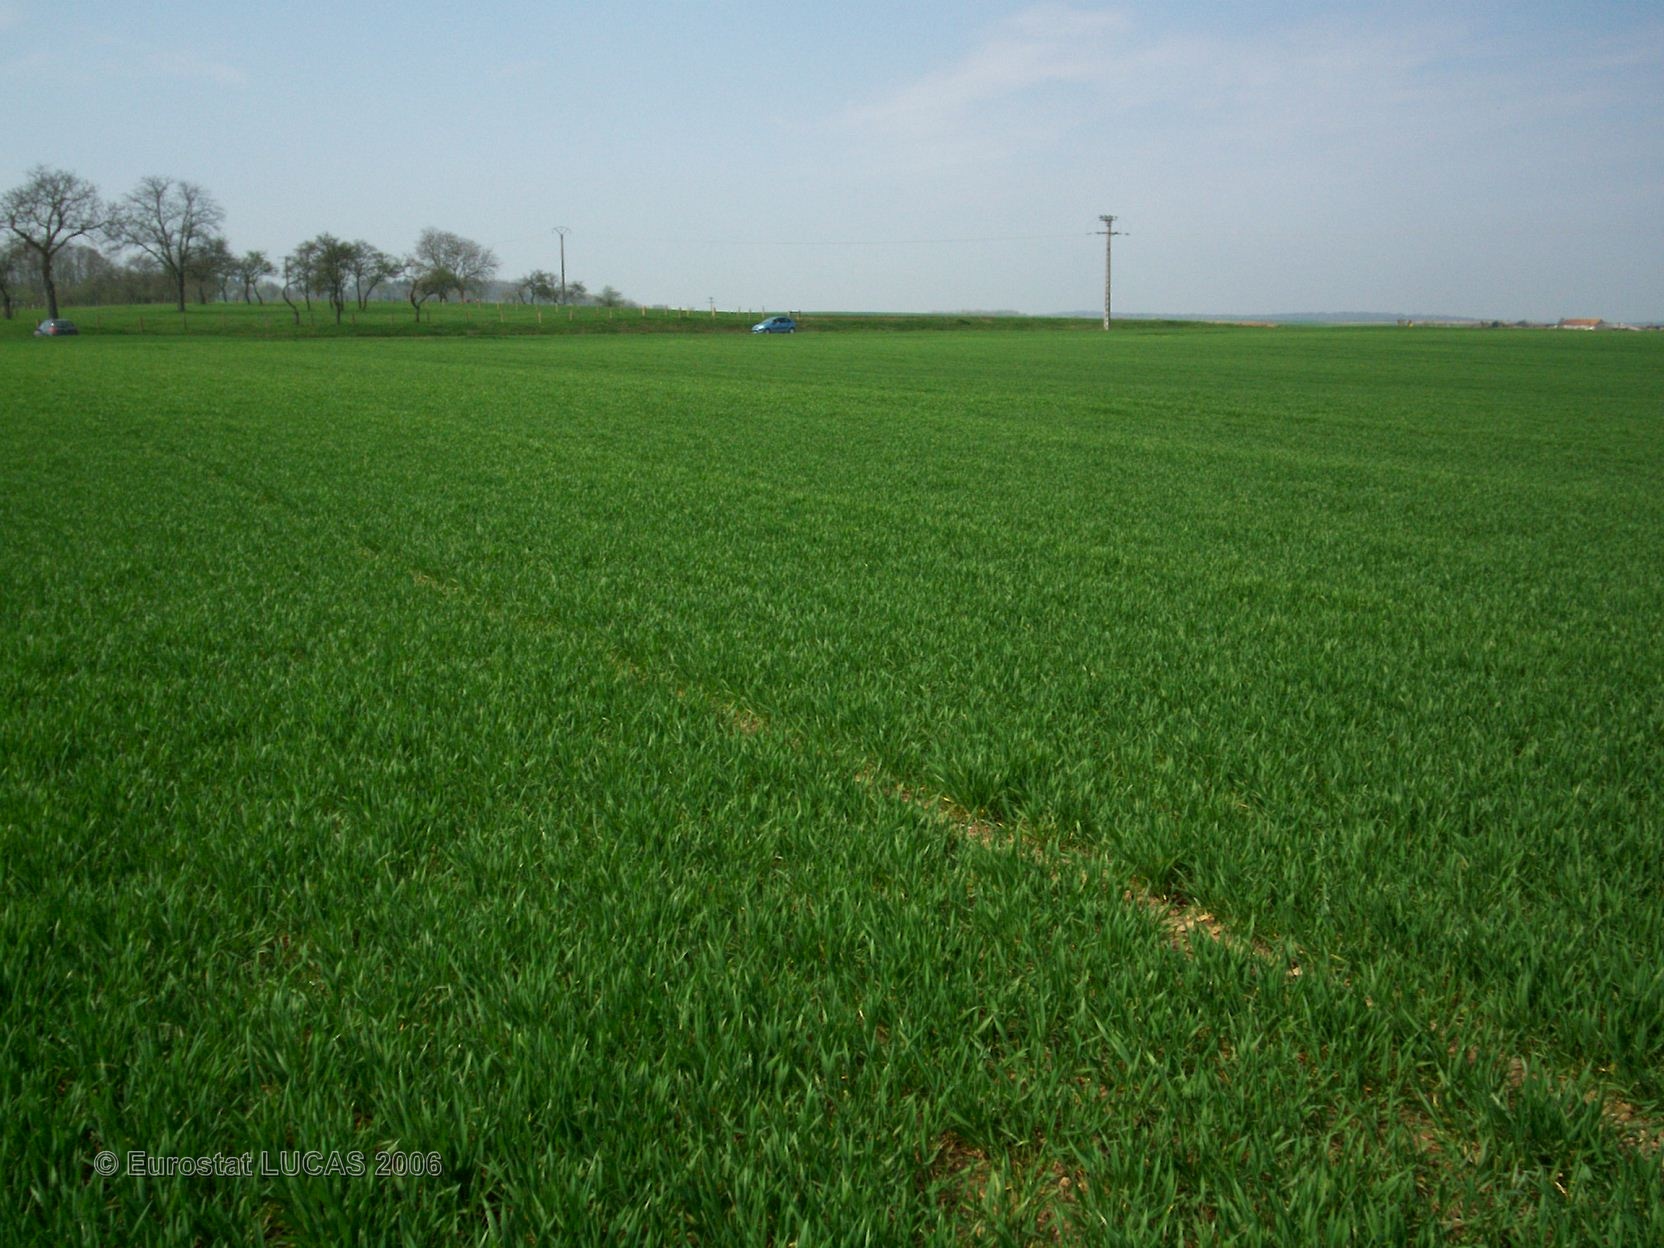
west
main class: Cropland
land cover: Common wheat
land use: Agriculture (excluding fallow land and kitchen gardens)
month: April
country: FR
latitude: 48.7274
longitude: 6.5337
